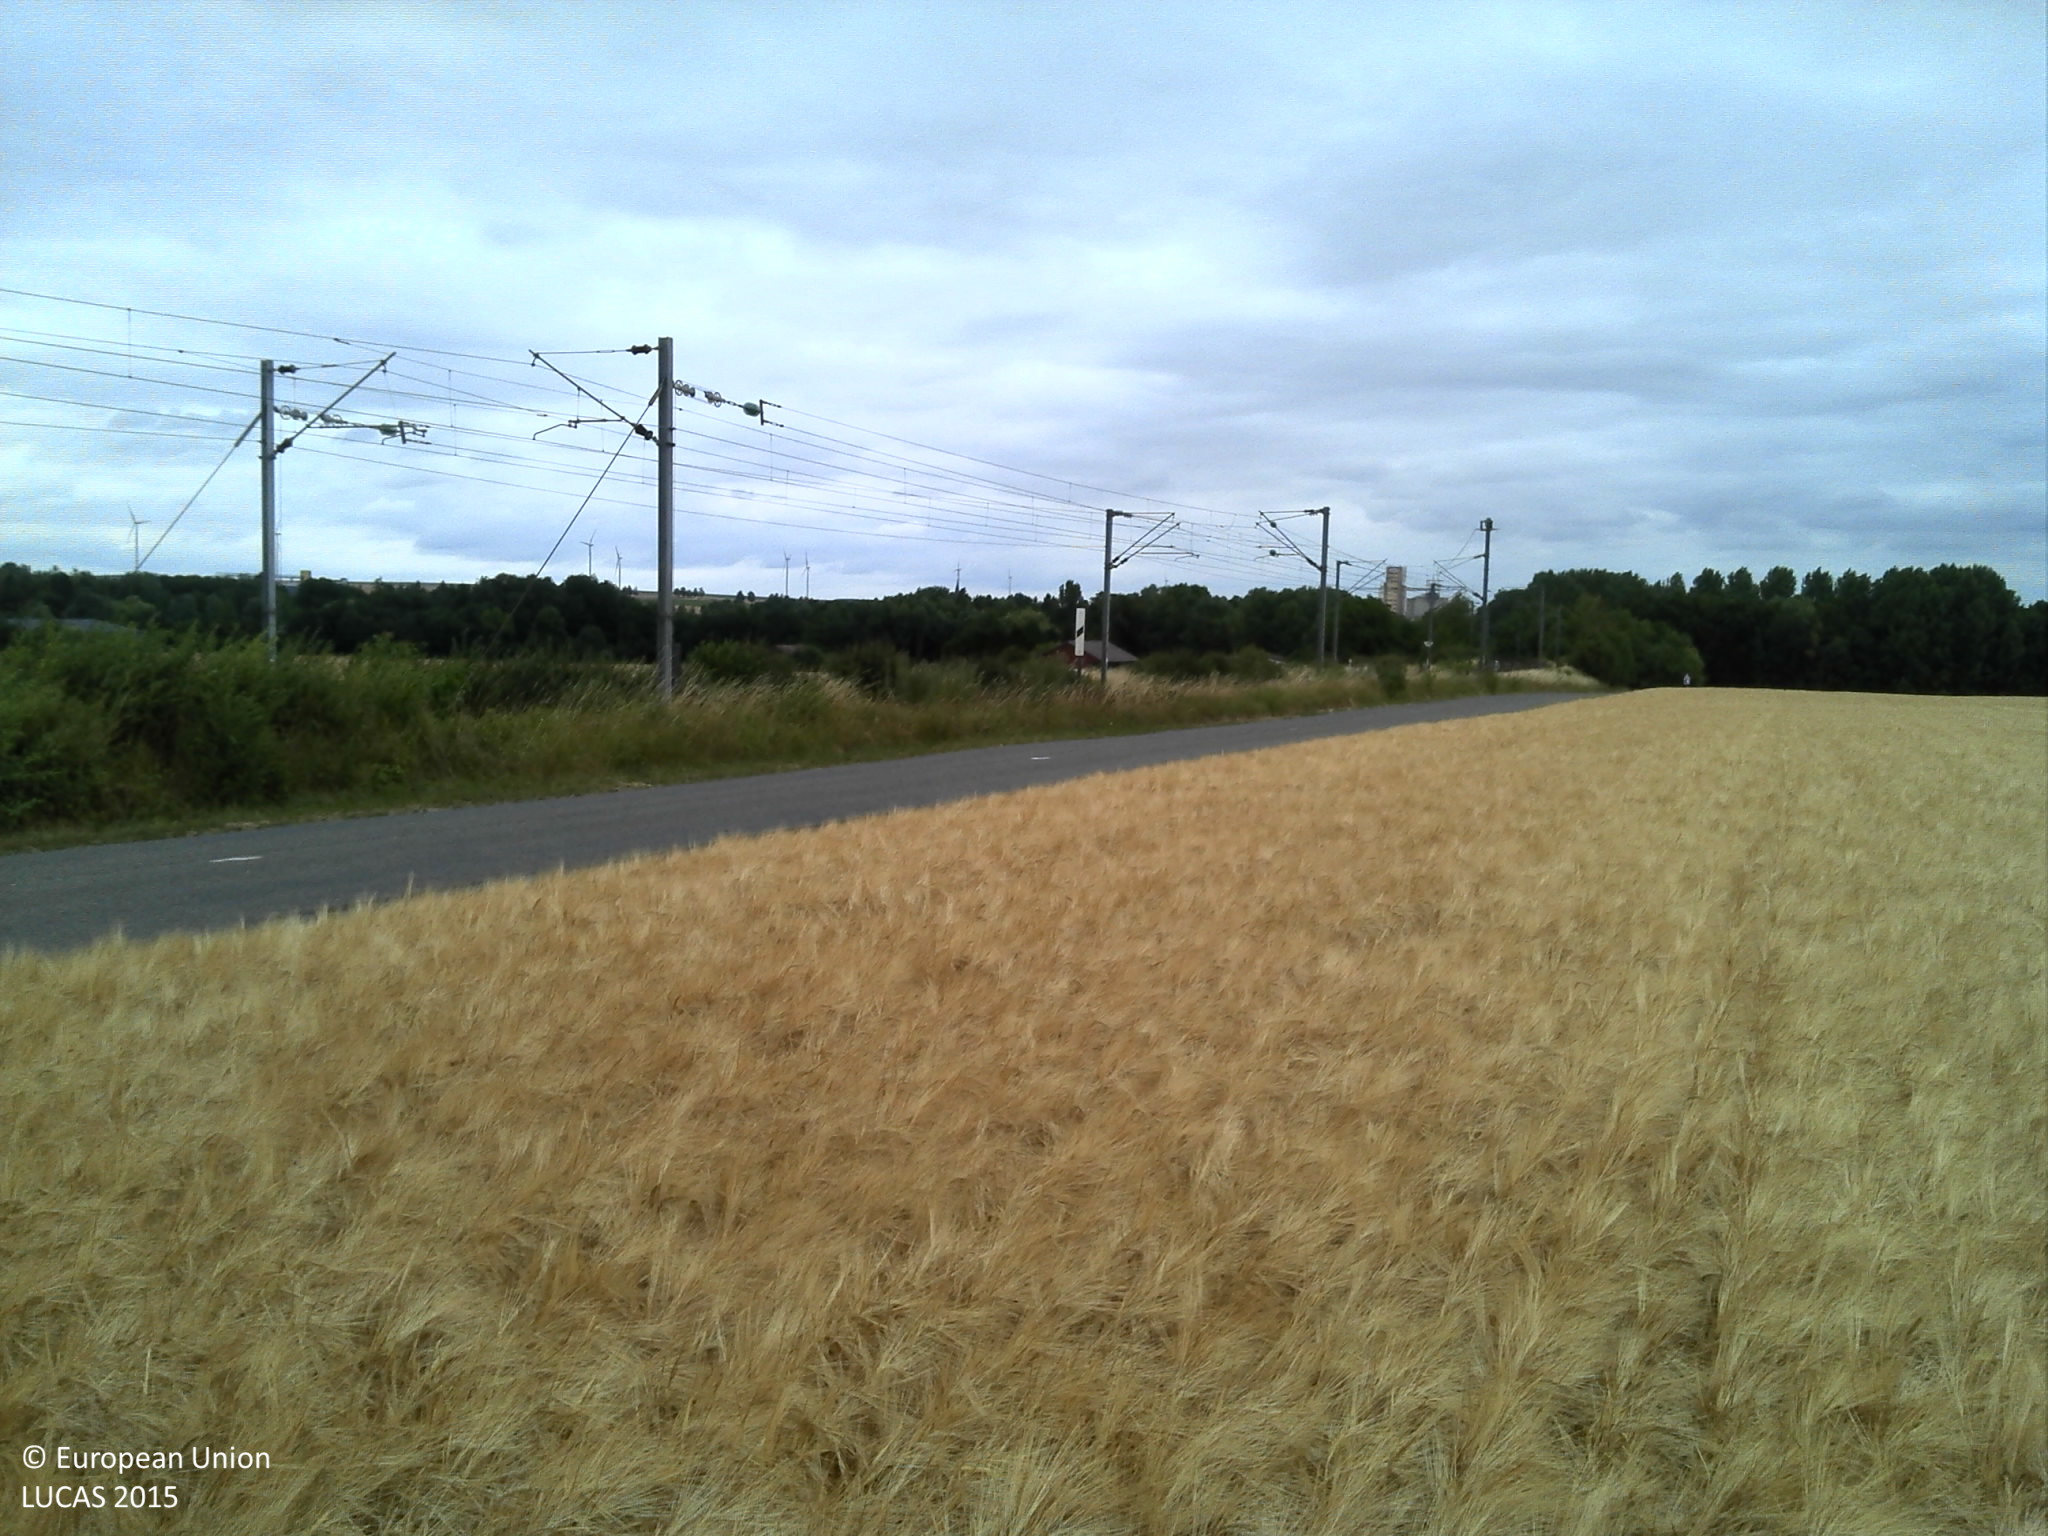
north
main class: Cropland
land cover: Barley
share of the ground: > 75 %
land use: Agriculture (excluding fallow land and kitchen gardens)
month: July
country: FR
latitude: 49.4094
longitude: 4.2759
